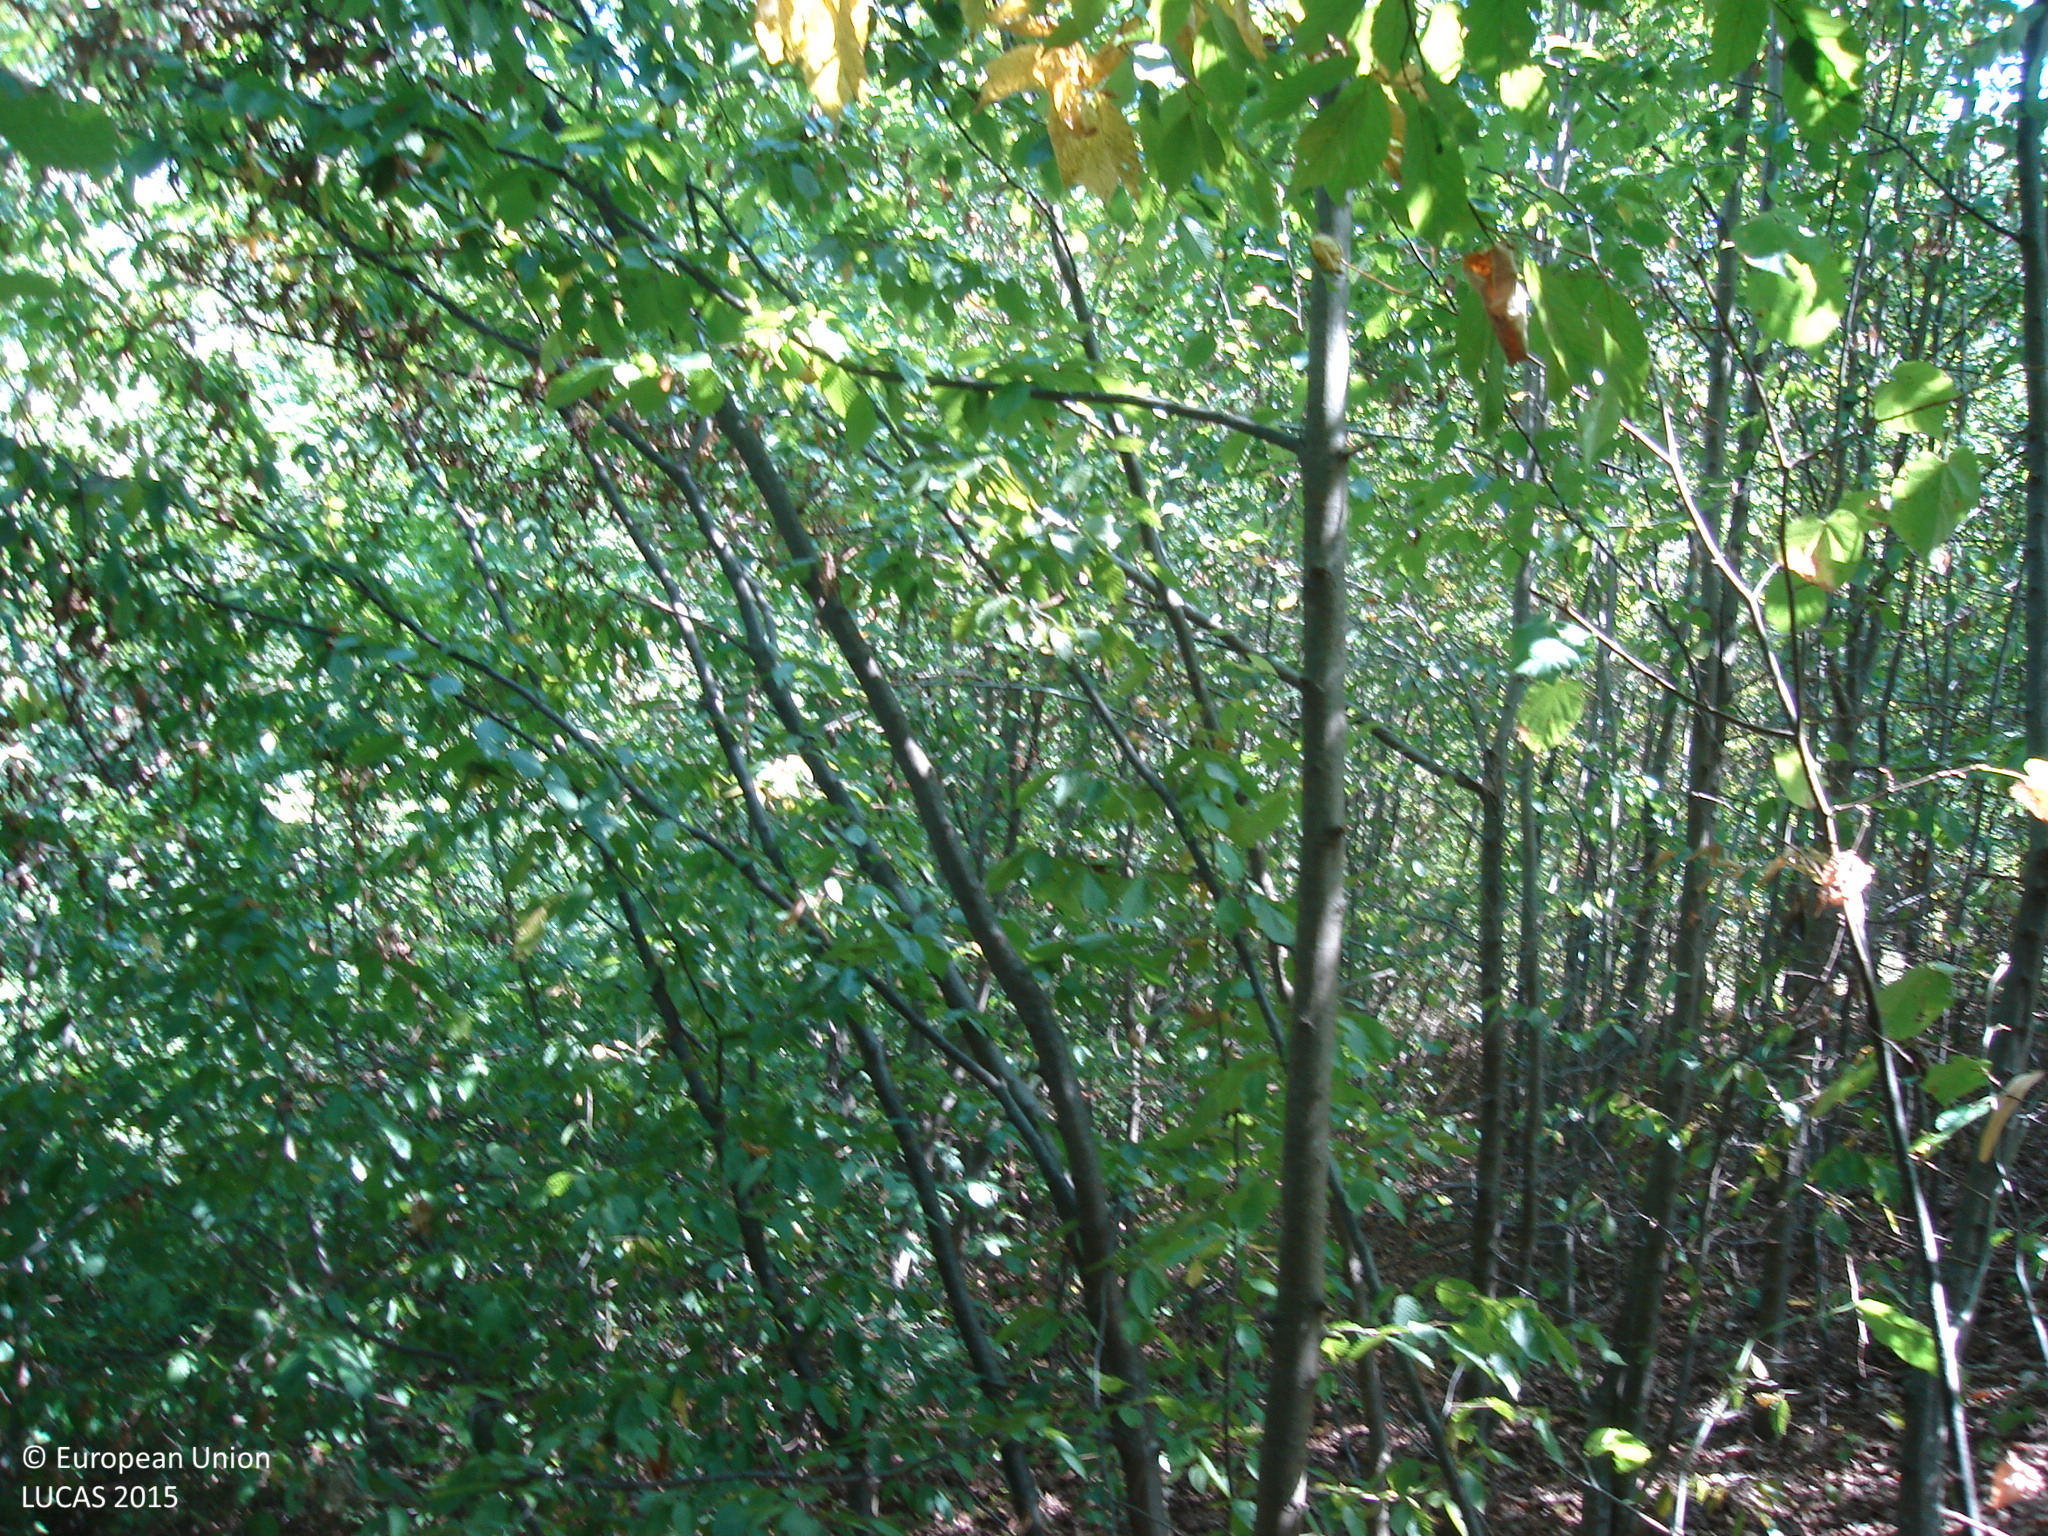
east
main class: Woodland
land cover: Broadleaved woodland
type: mesophytic deciduous forest
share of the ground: > 75 %
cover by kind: broadleaved forest trees 95 %, consolidated bare surface 5 %
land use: Forestry
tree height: > 5 m
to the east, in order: Broadleaved woodland; Rivers and streams; Broadleaved woodland; Tracks; Grassland with sparse tree/shrub cover
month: September
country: BG
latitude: 42.8386
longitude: 23.9315
